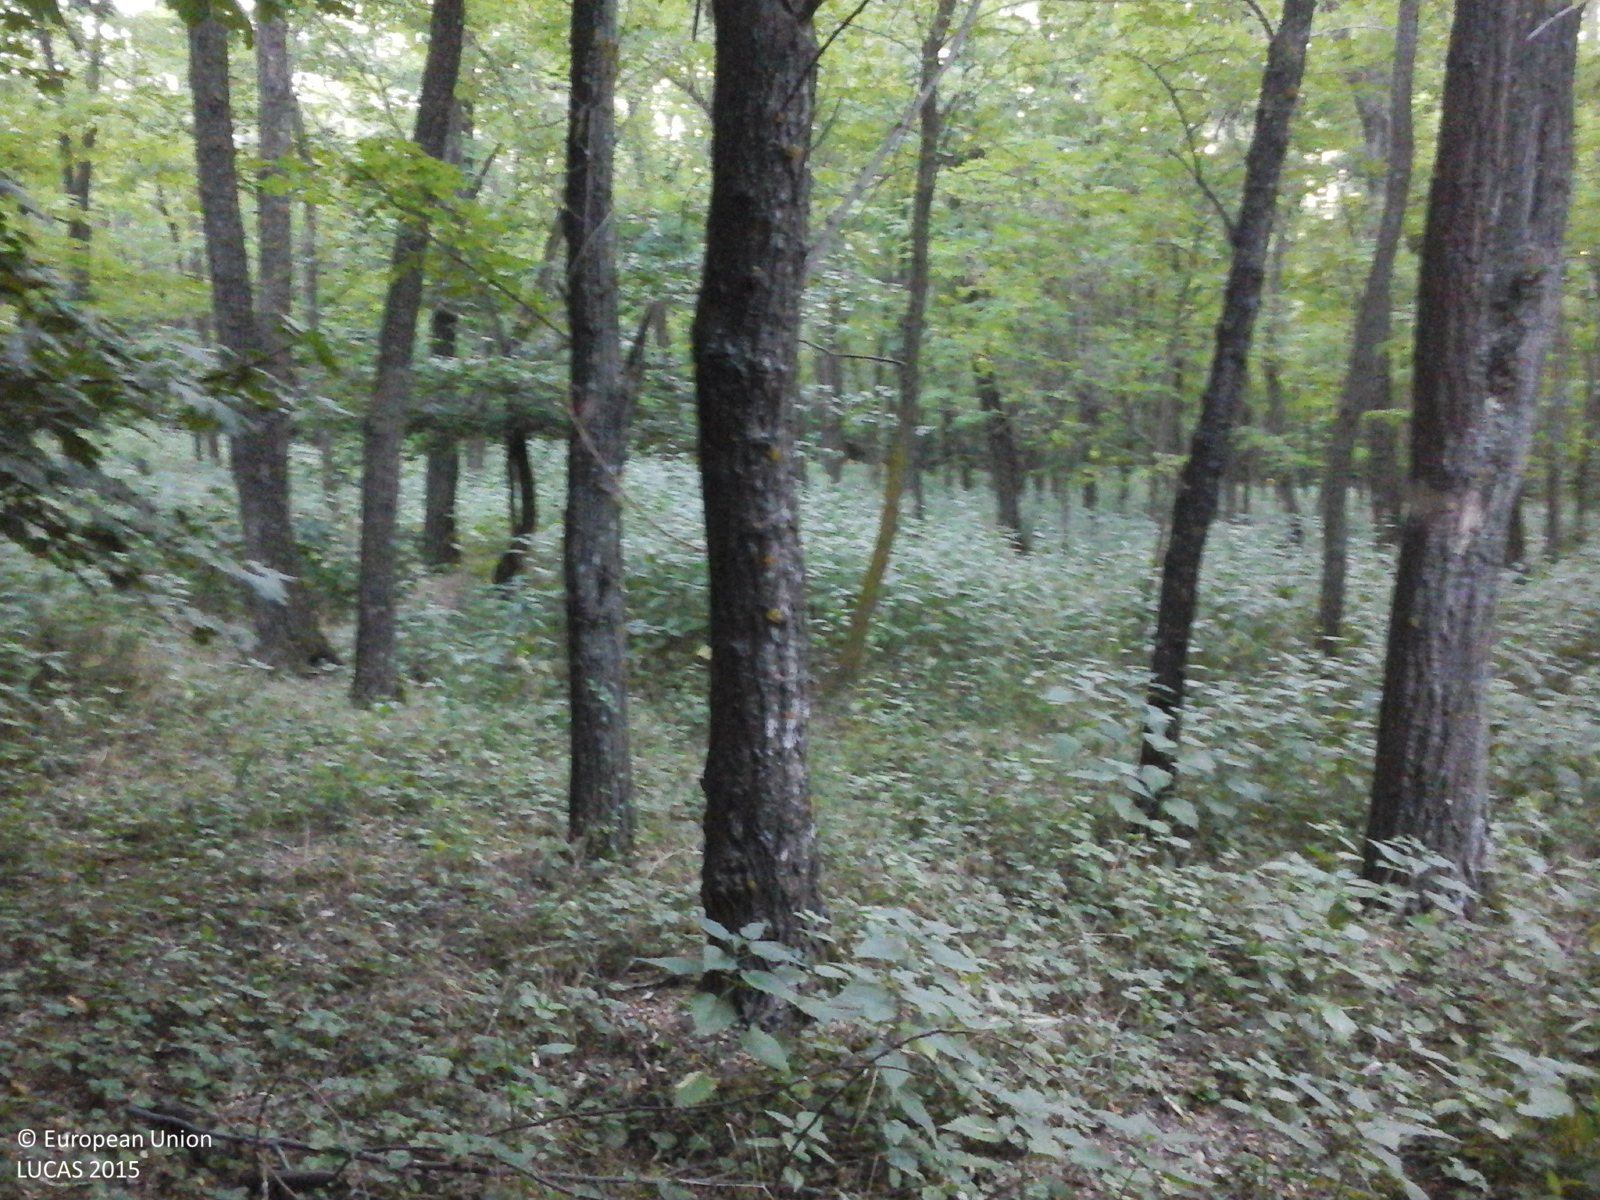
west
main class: Woodland
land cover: Broadleaved woodland
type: mesophytic deciduous forest
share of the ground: > 75 %
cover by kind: broadleaved forest trees 90 %, herbaceous plants 10 %
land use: Forestry
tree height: > 5 m
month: June
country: RO
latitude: 47.4071
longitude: 27.2172
